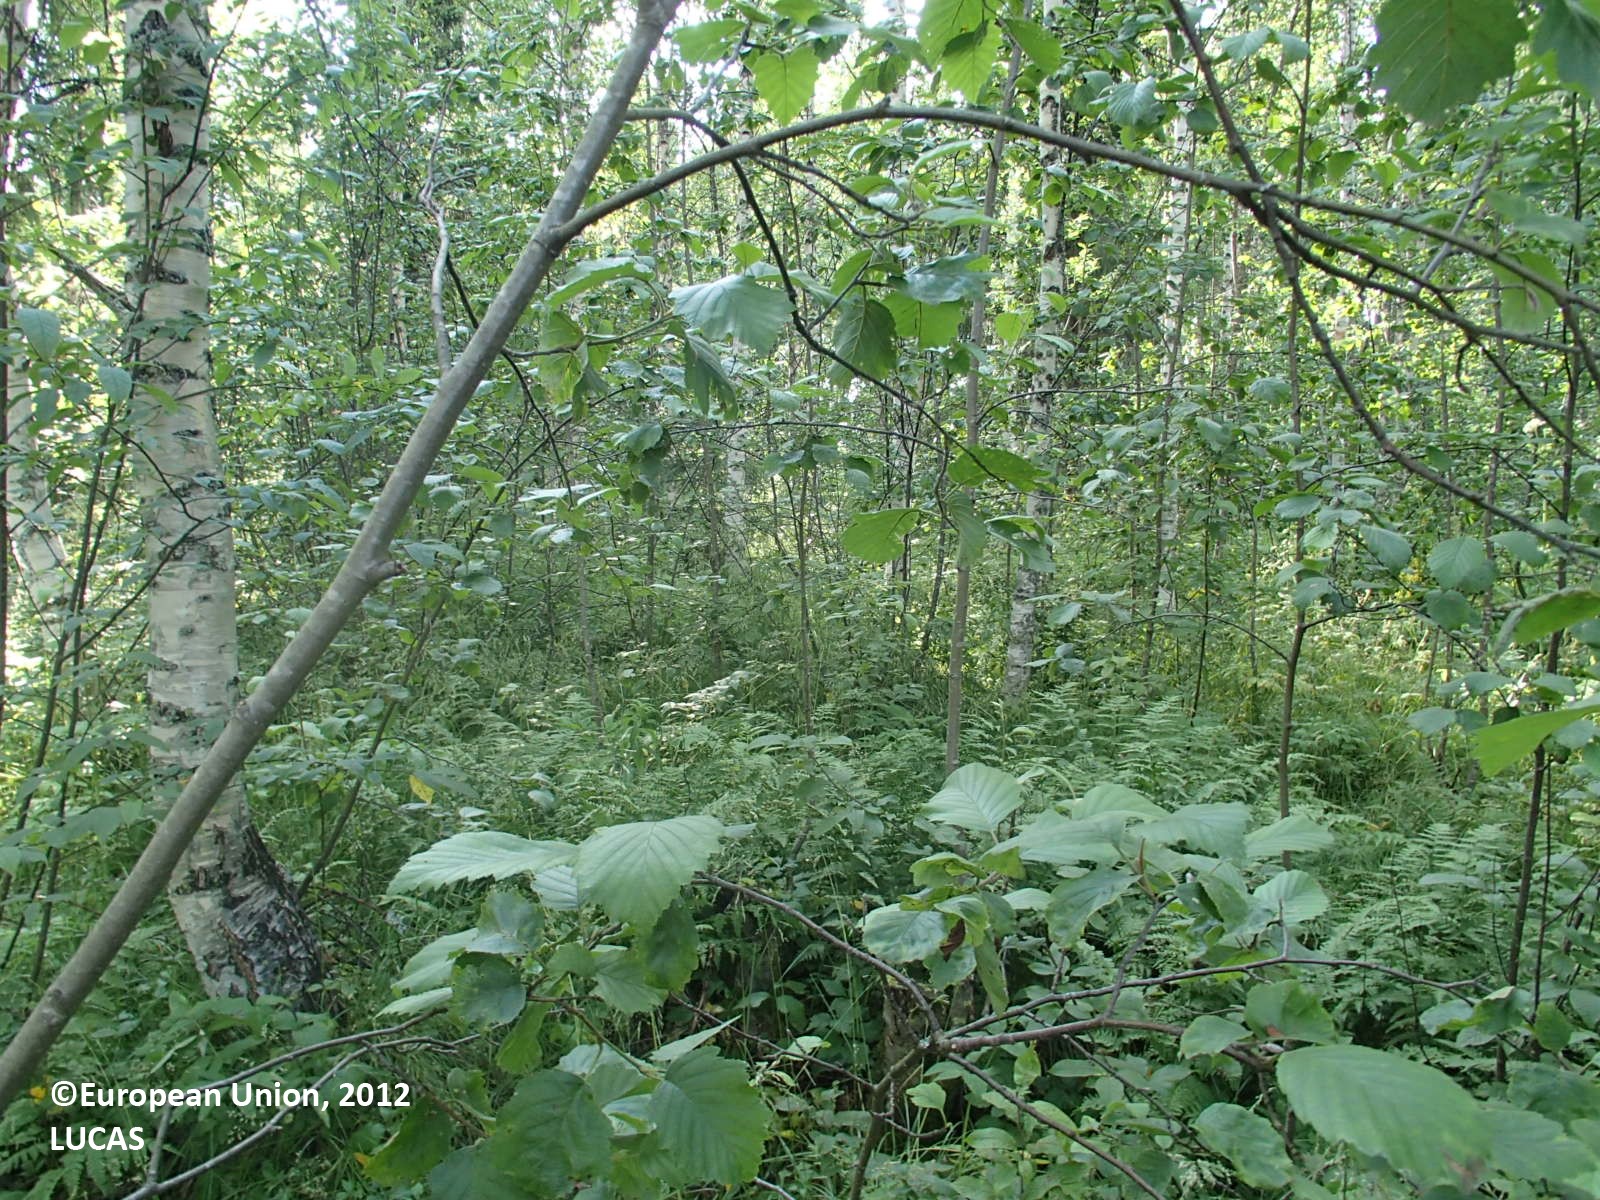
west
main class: Woodland
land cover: Spruce dominated mixed woodland
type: boreal forest
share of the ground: > 75 %
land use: Forestry
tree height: > 5 m
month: July
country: FI
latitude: 63.8944
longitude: 27.3584
